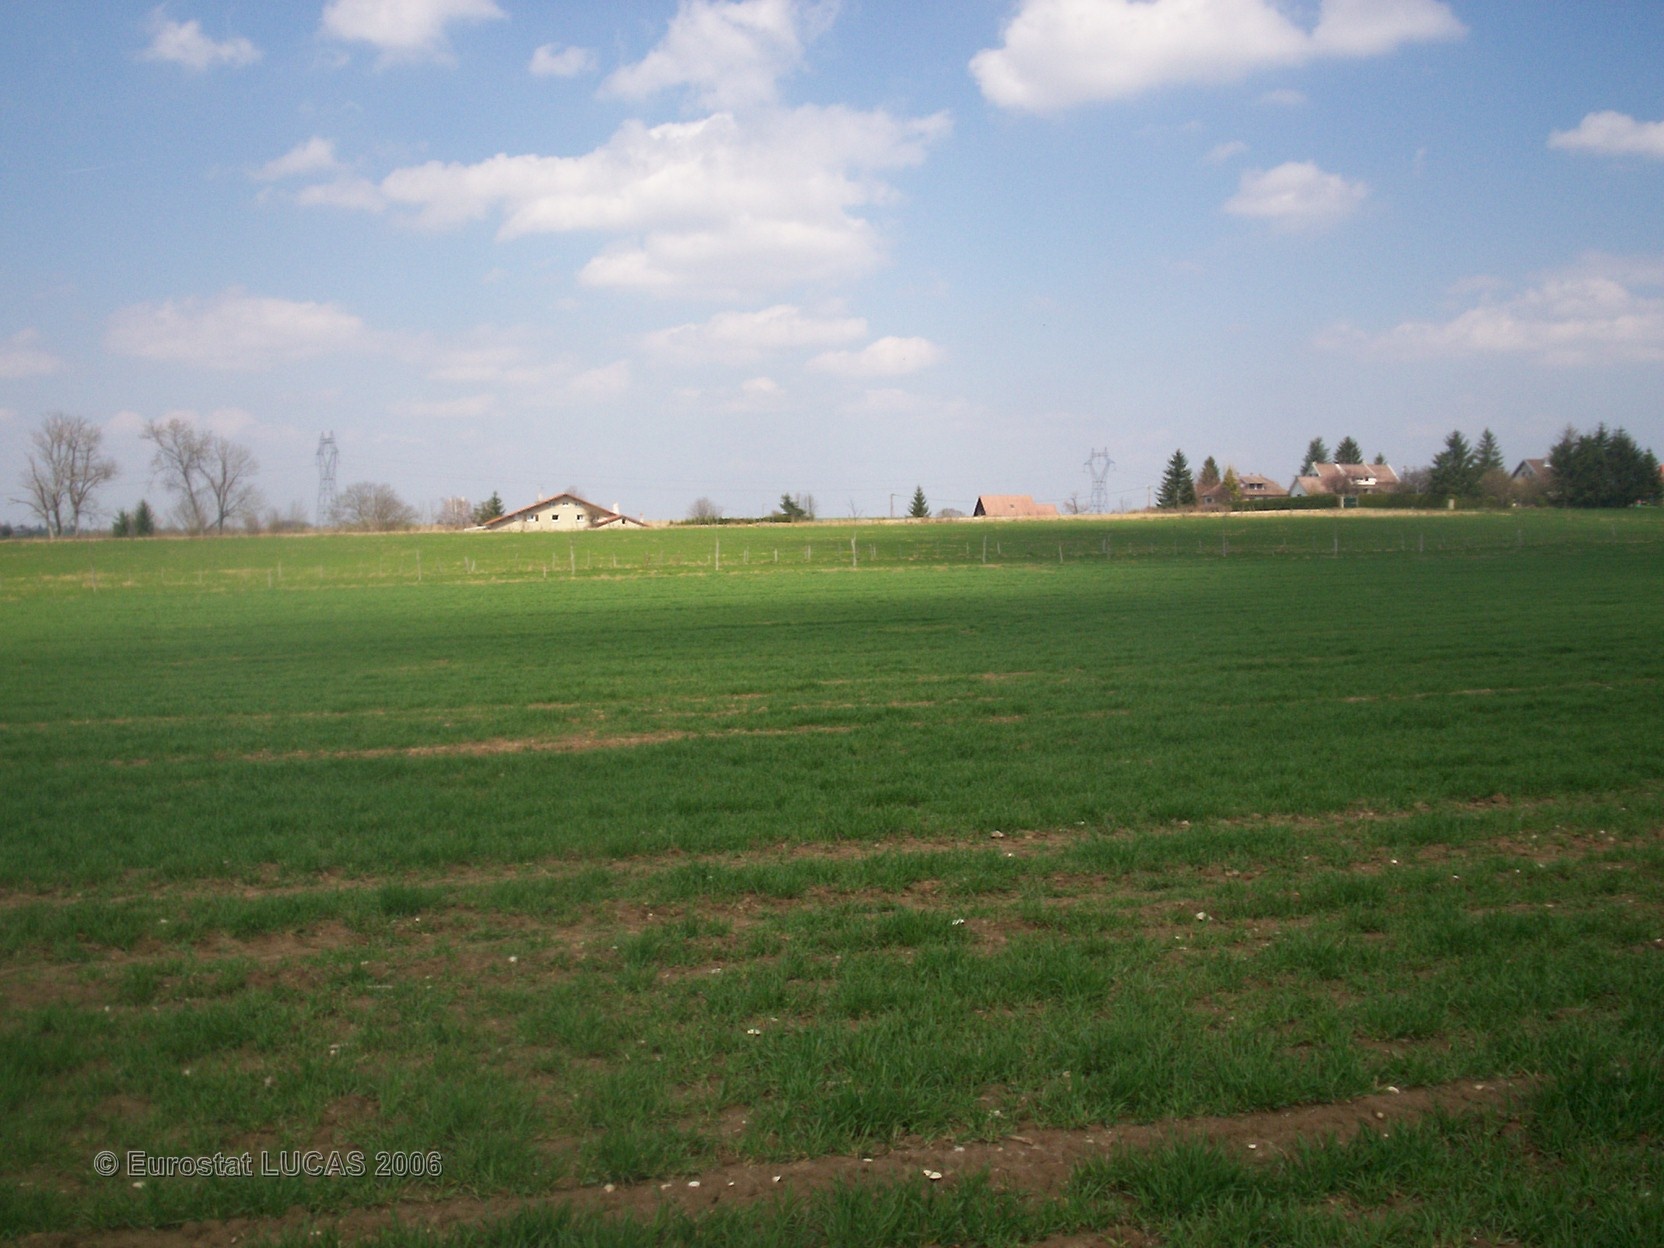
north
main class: Cropland
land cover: Barley
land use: Agriculture (excluding fallow land and kitchen gardens)
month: April
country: FR
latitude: 47.3856
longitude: 6.8359
